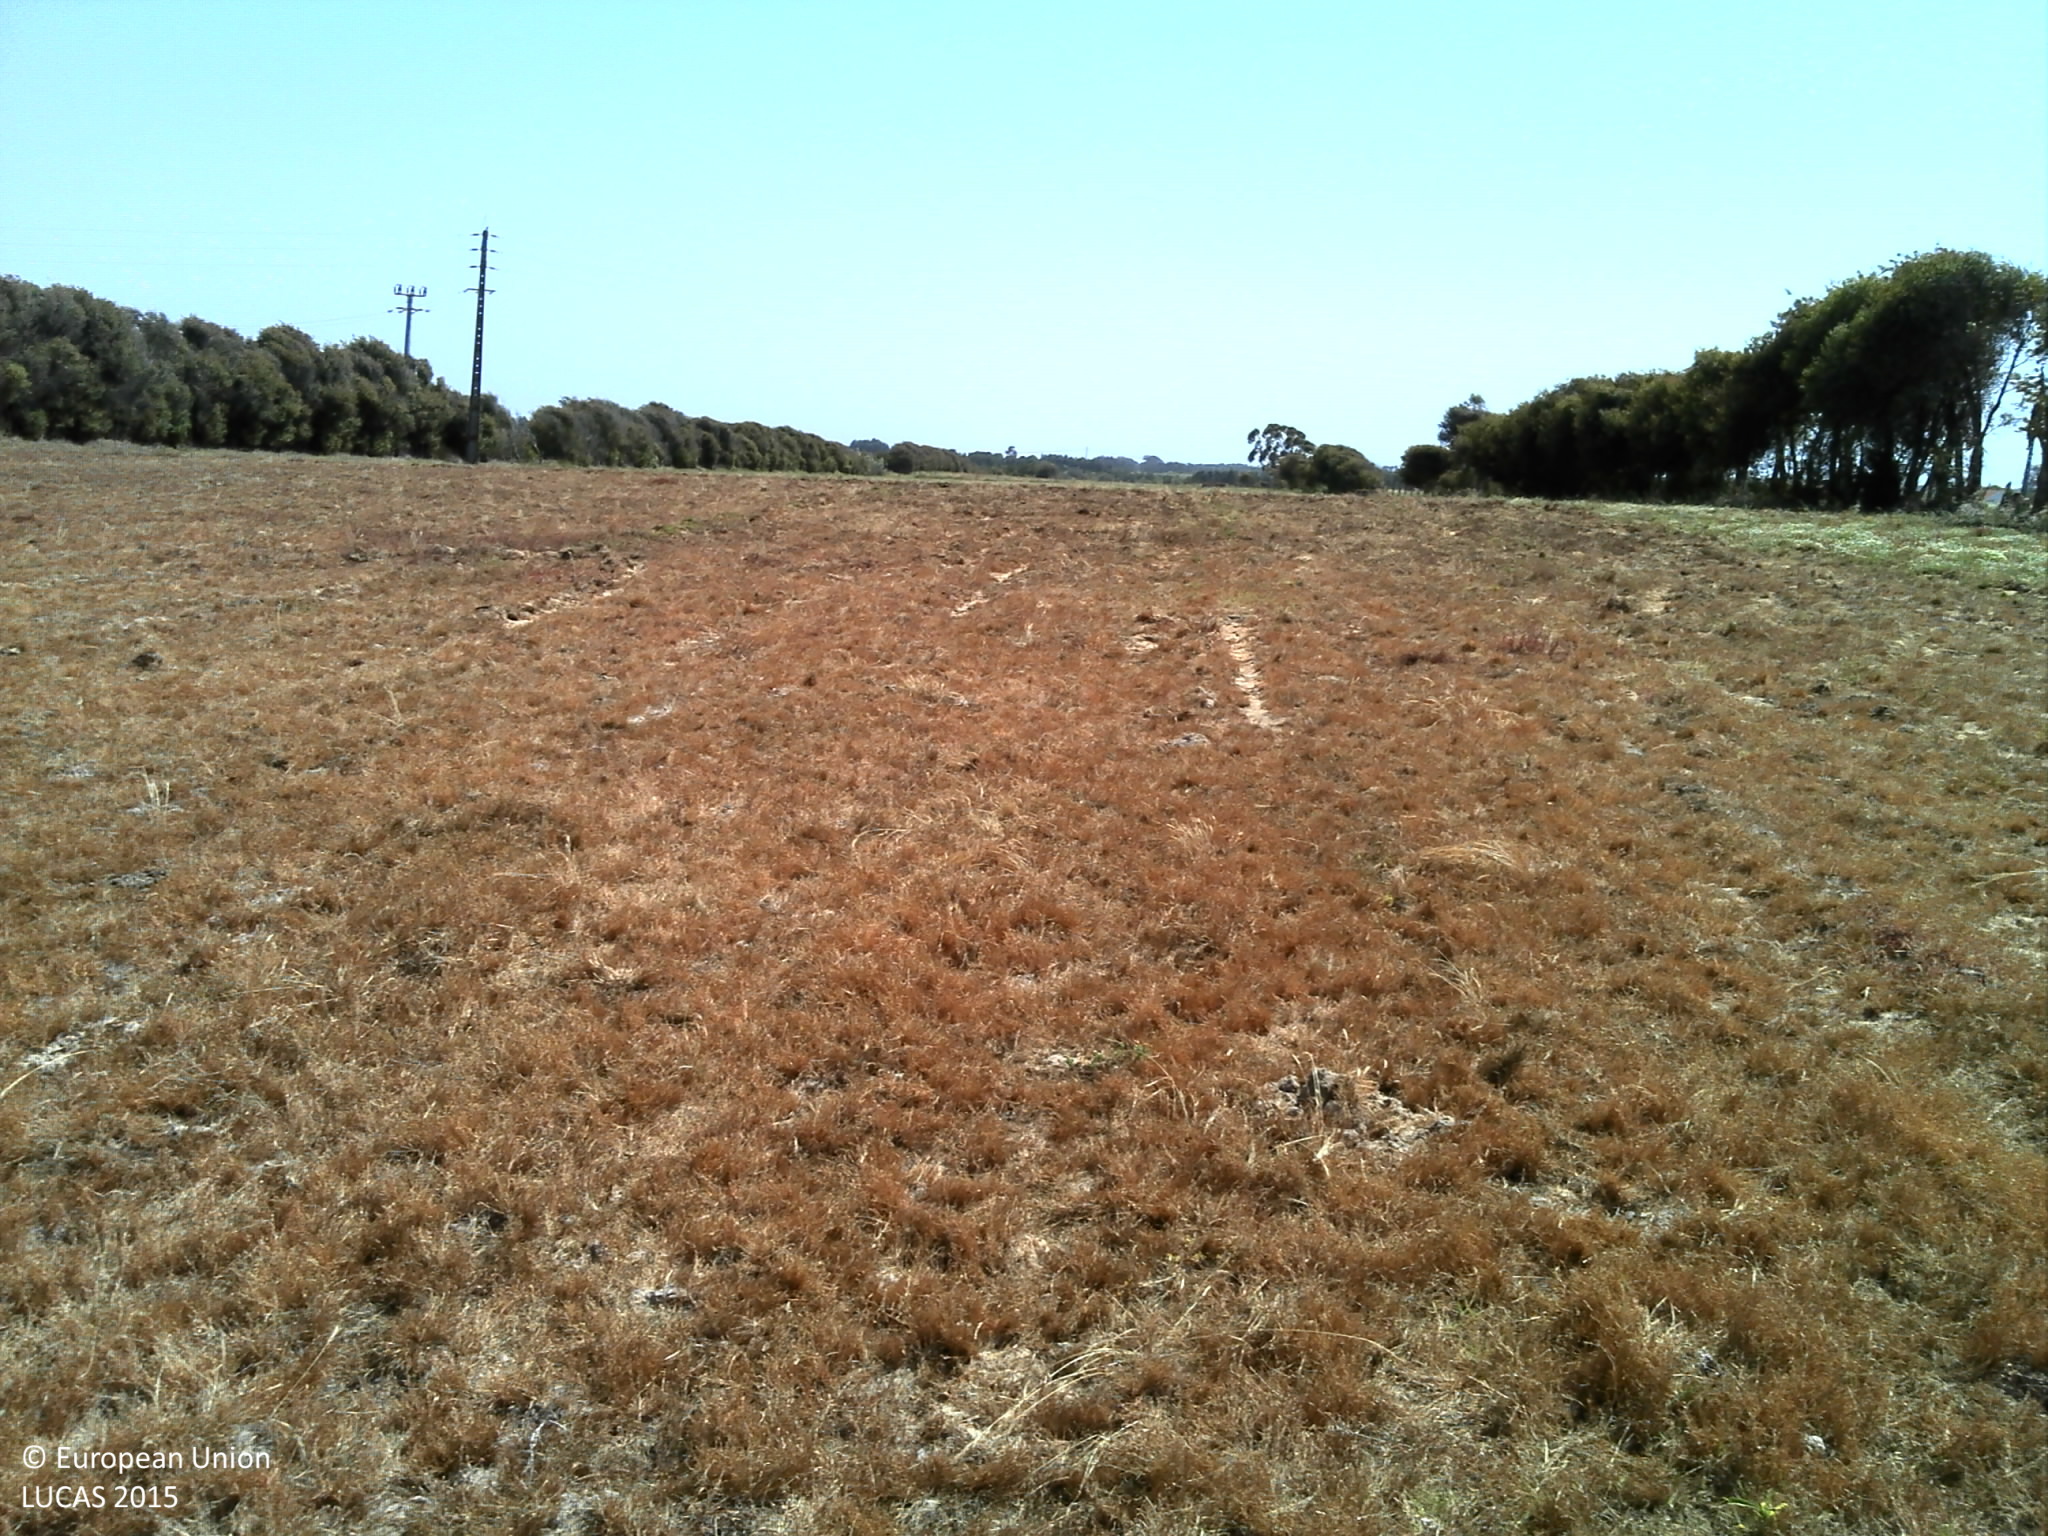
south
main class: Grassland
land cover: Grassland without tree/shrub cover
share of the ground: > 75 %
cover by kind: herbaceous plants 80 %, consolidated bare surface 20 %
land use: Agriculture (excluding fallow land and kitchen gardens)
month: May
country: PT
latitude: 37.5298
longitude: -8.7679
